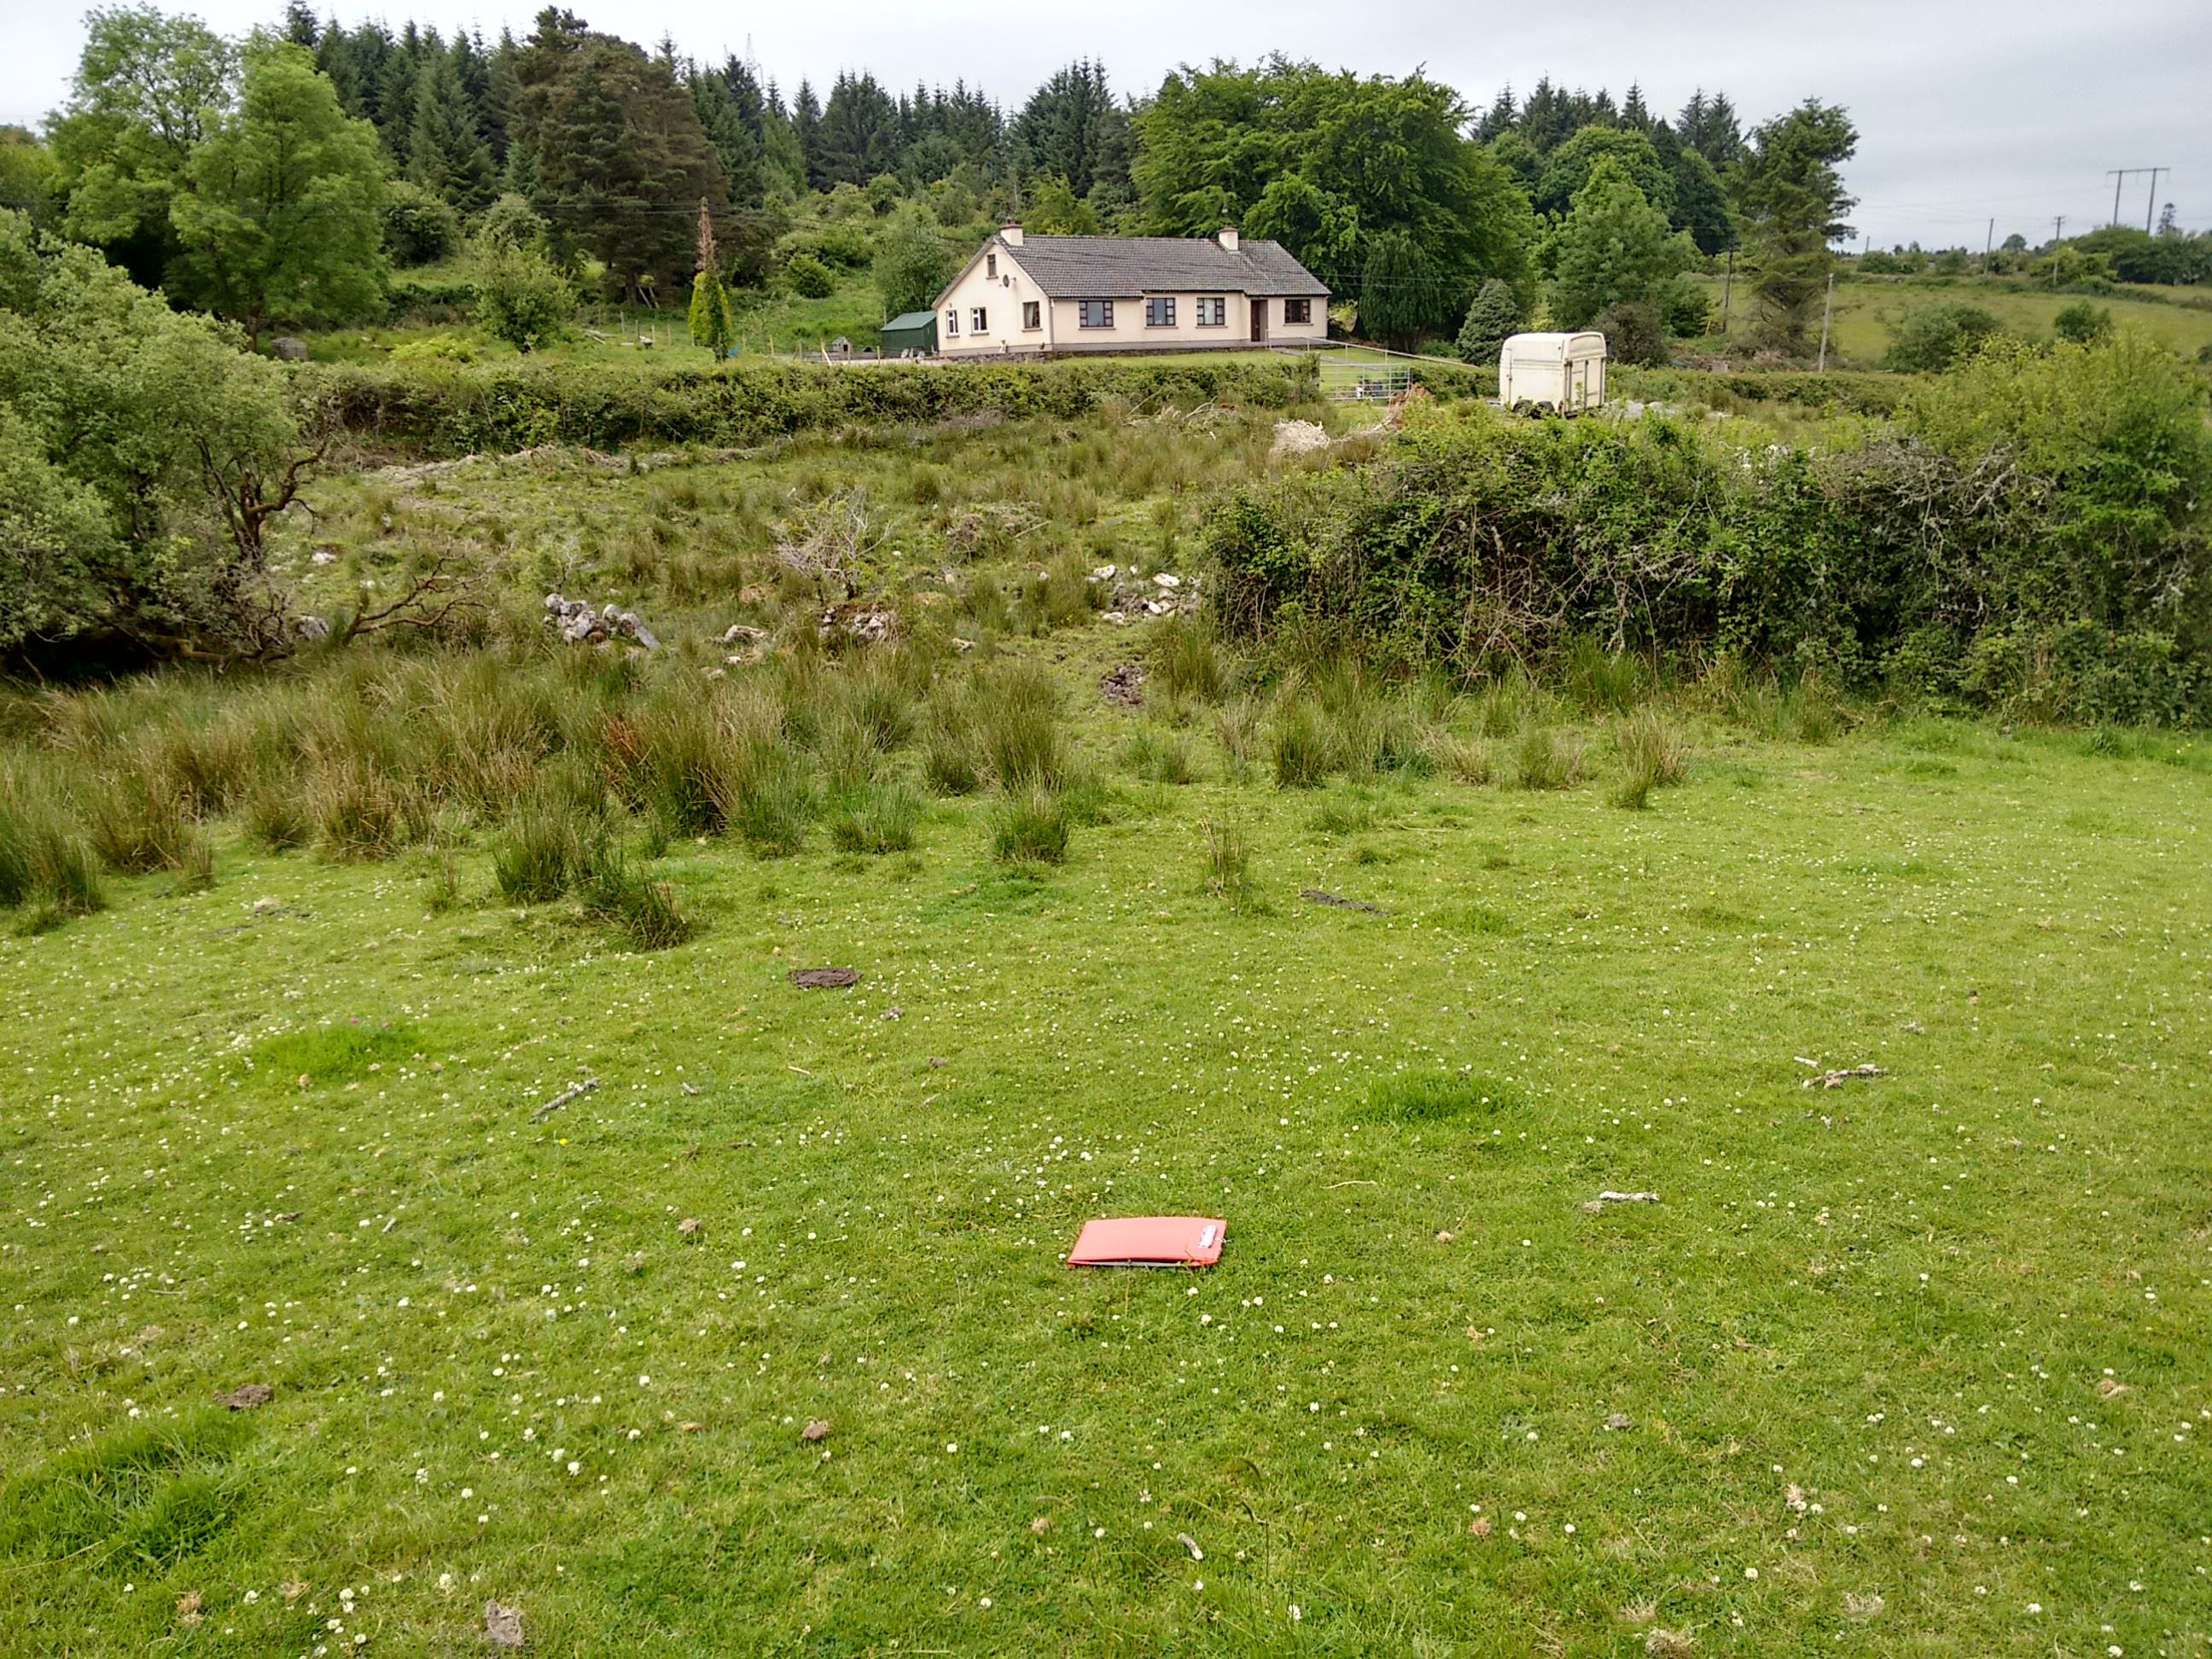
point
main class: Grassland
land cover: Grassland with sparse tree/shrub cover
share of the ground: > 75 %
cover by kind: herbaceous plants 85 %, shrubs 10 %, broadleaved forest trees 5 %
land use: Agriculture (excluding fallow land and kitchen gardens)
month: June
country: IE
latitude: 53.0701
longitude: -8.4757
